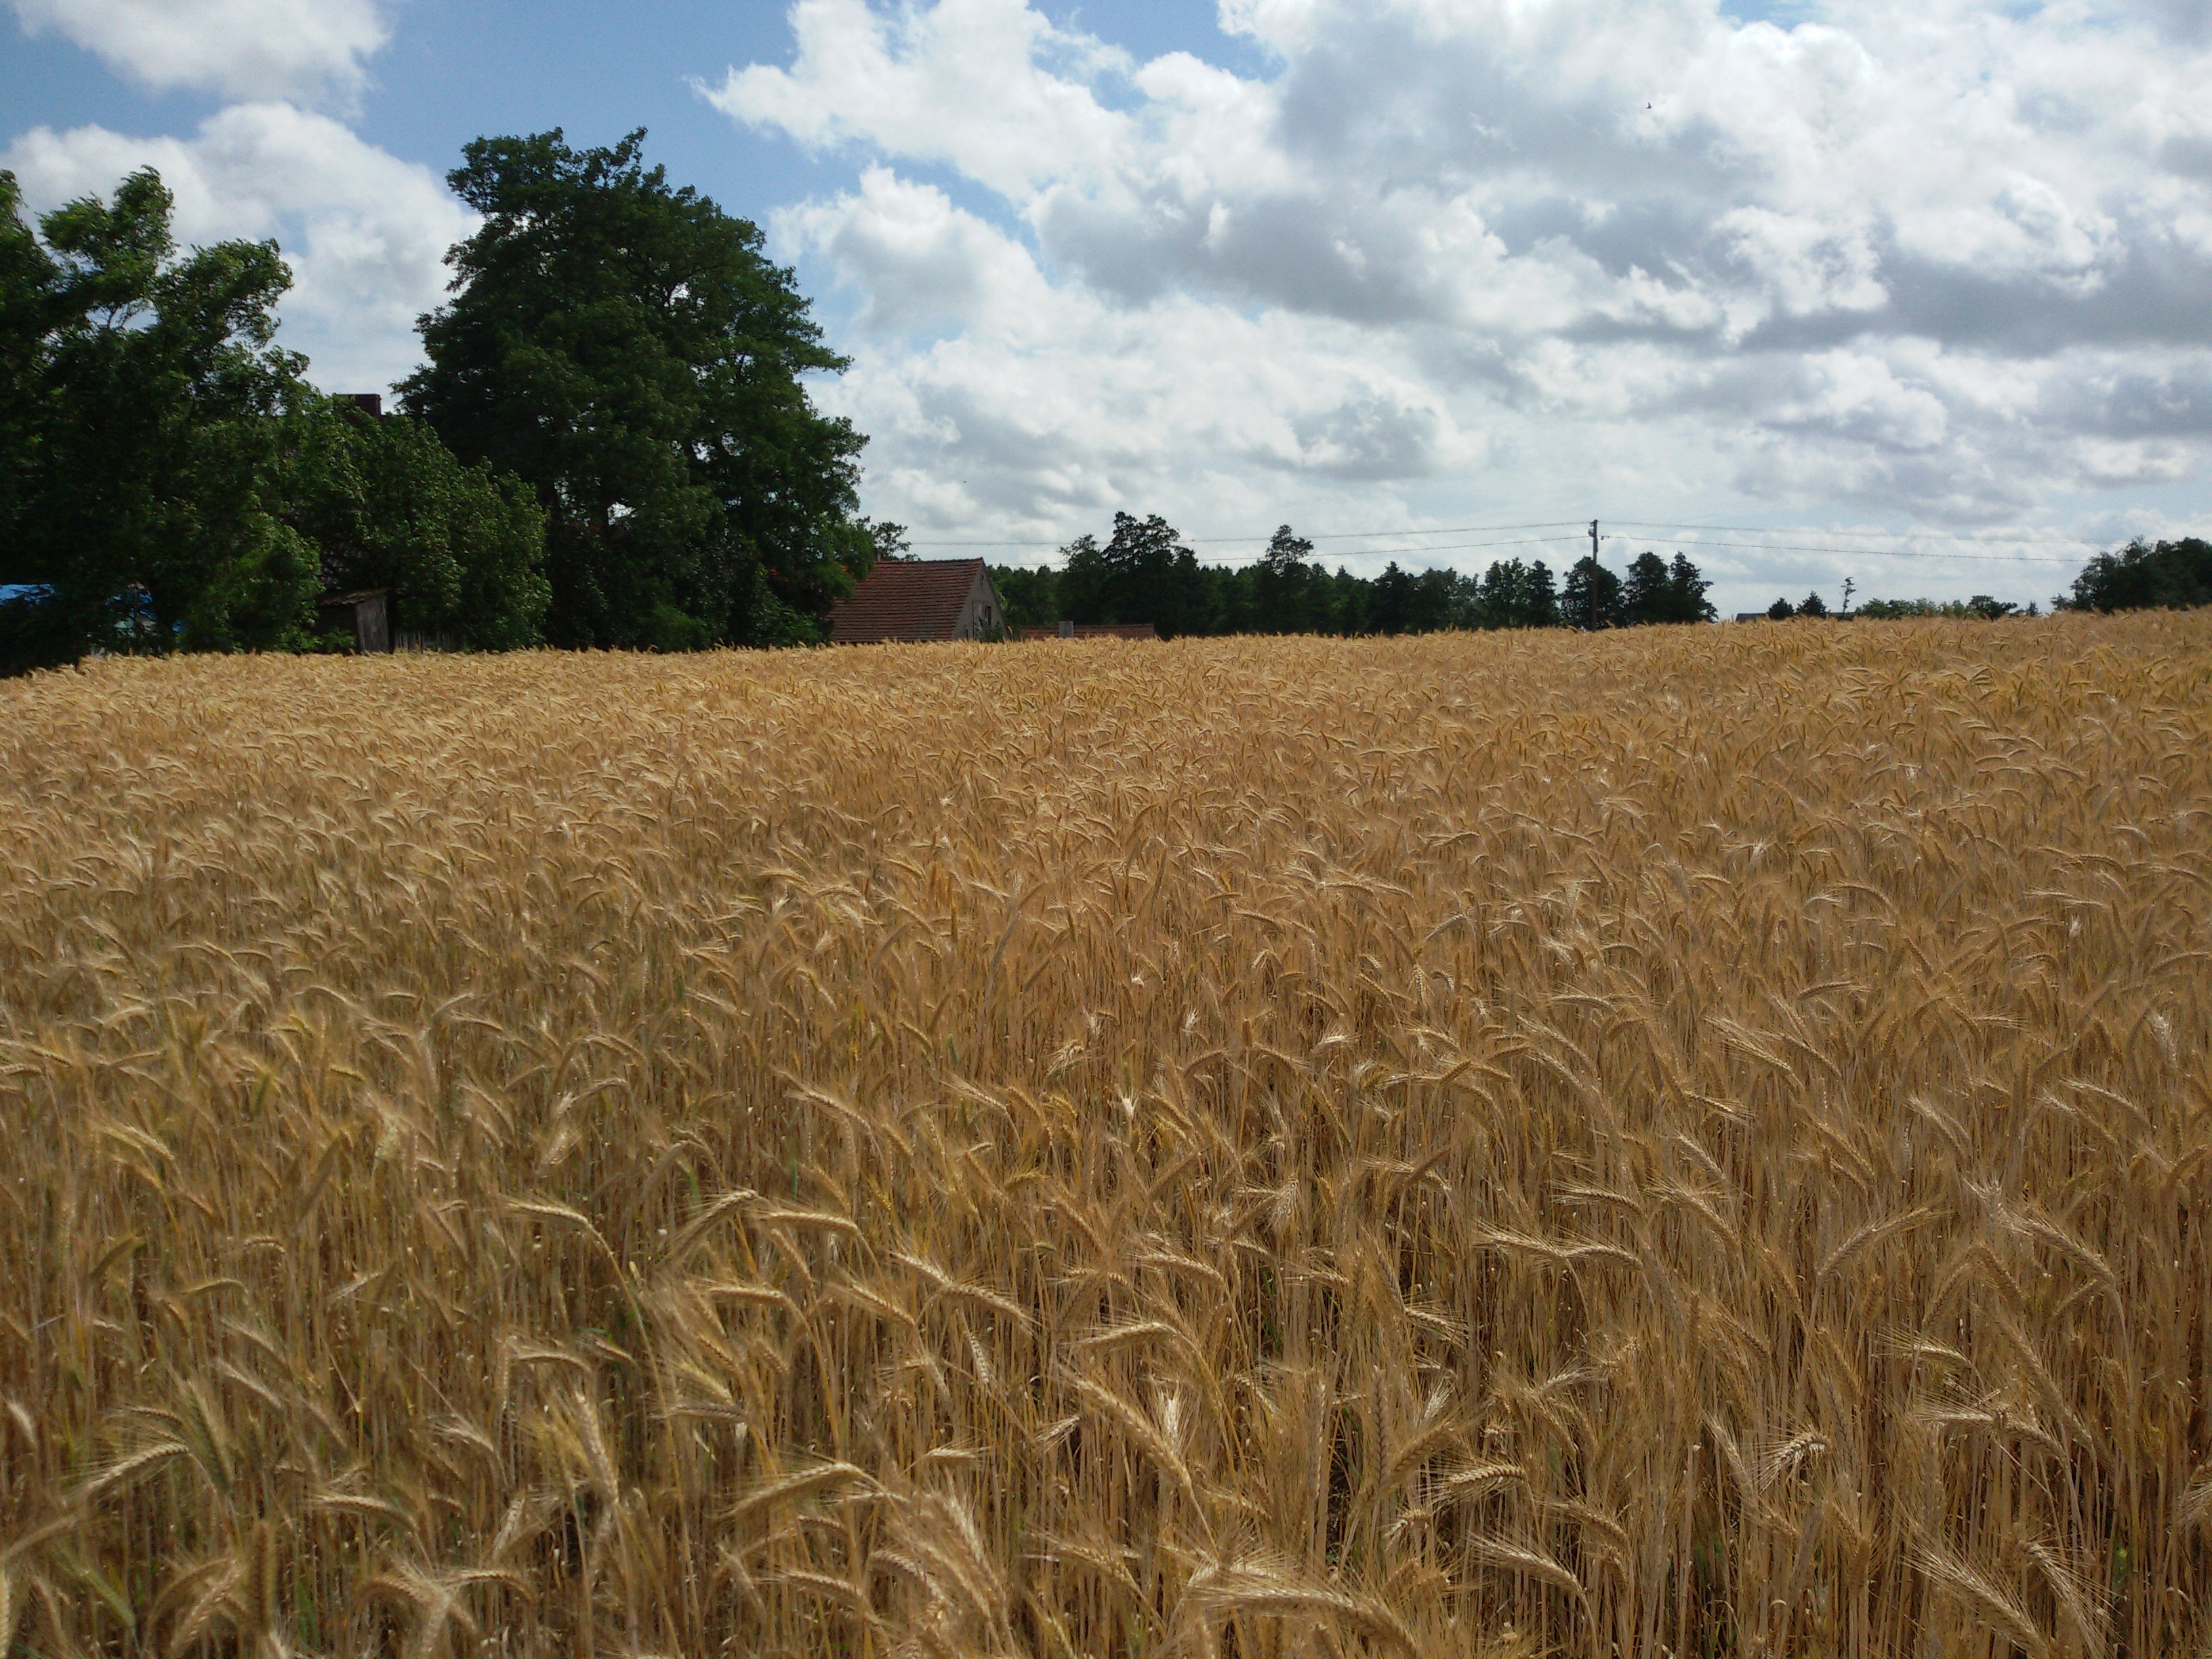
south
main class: Cropland
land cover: Triticale
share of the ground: > 75 %
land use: Agriculture (excluding fallow land and kitchen gardens)
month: July
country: PL
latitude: 52.8004
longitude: 17.6219
